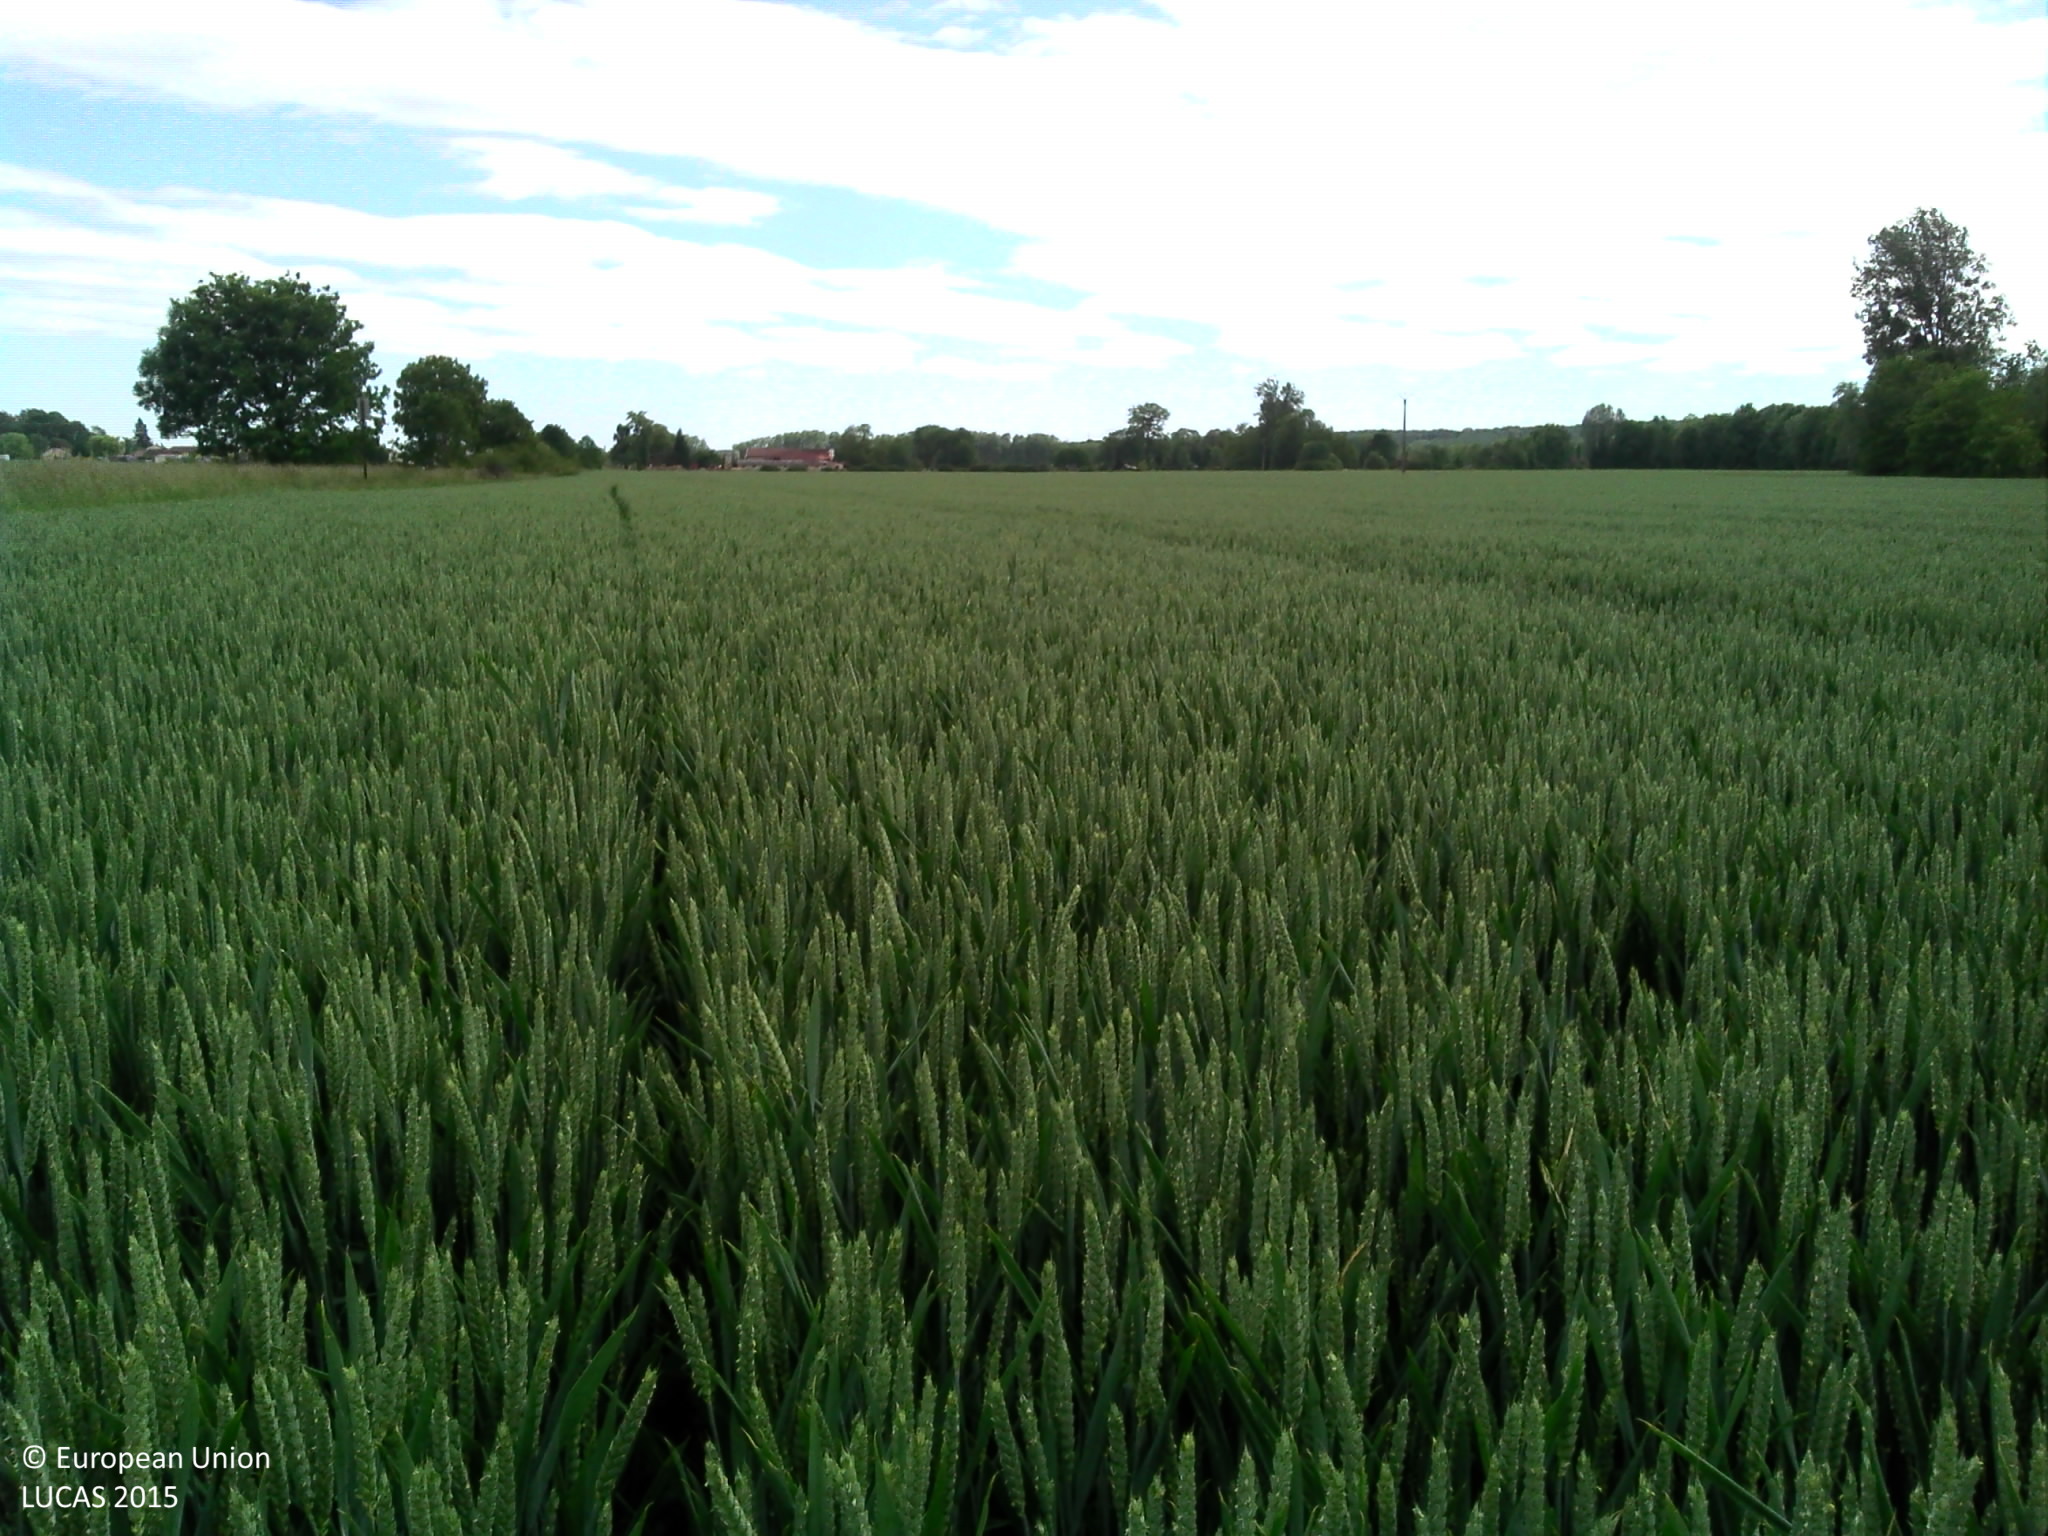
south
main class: Cropland
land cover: Common wheat
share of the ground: > 75 %
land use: Agriculture (excluding fallow land and kitchen gardens)
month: June
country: FR
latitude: 48.5571
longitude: 4.9173
